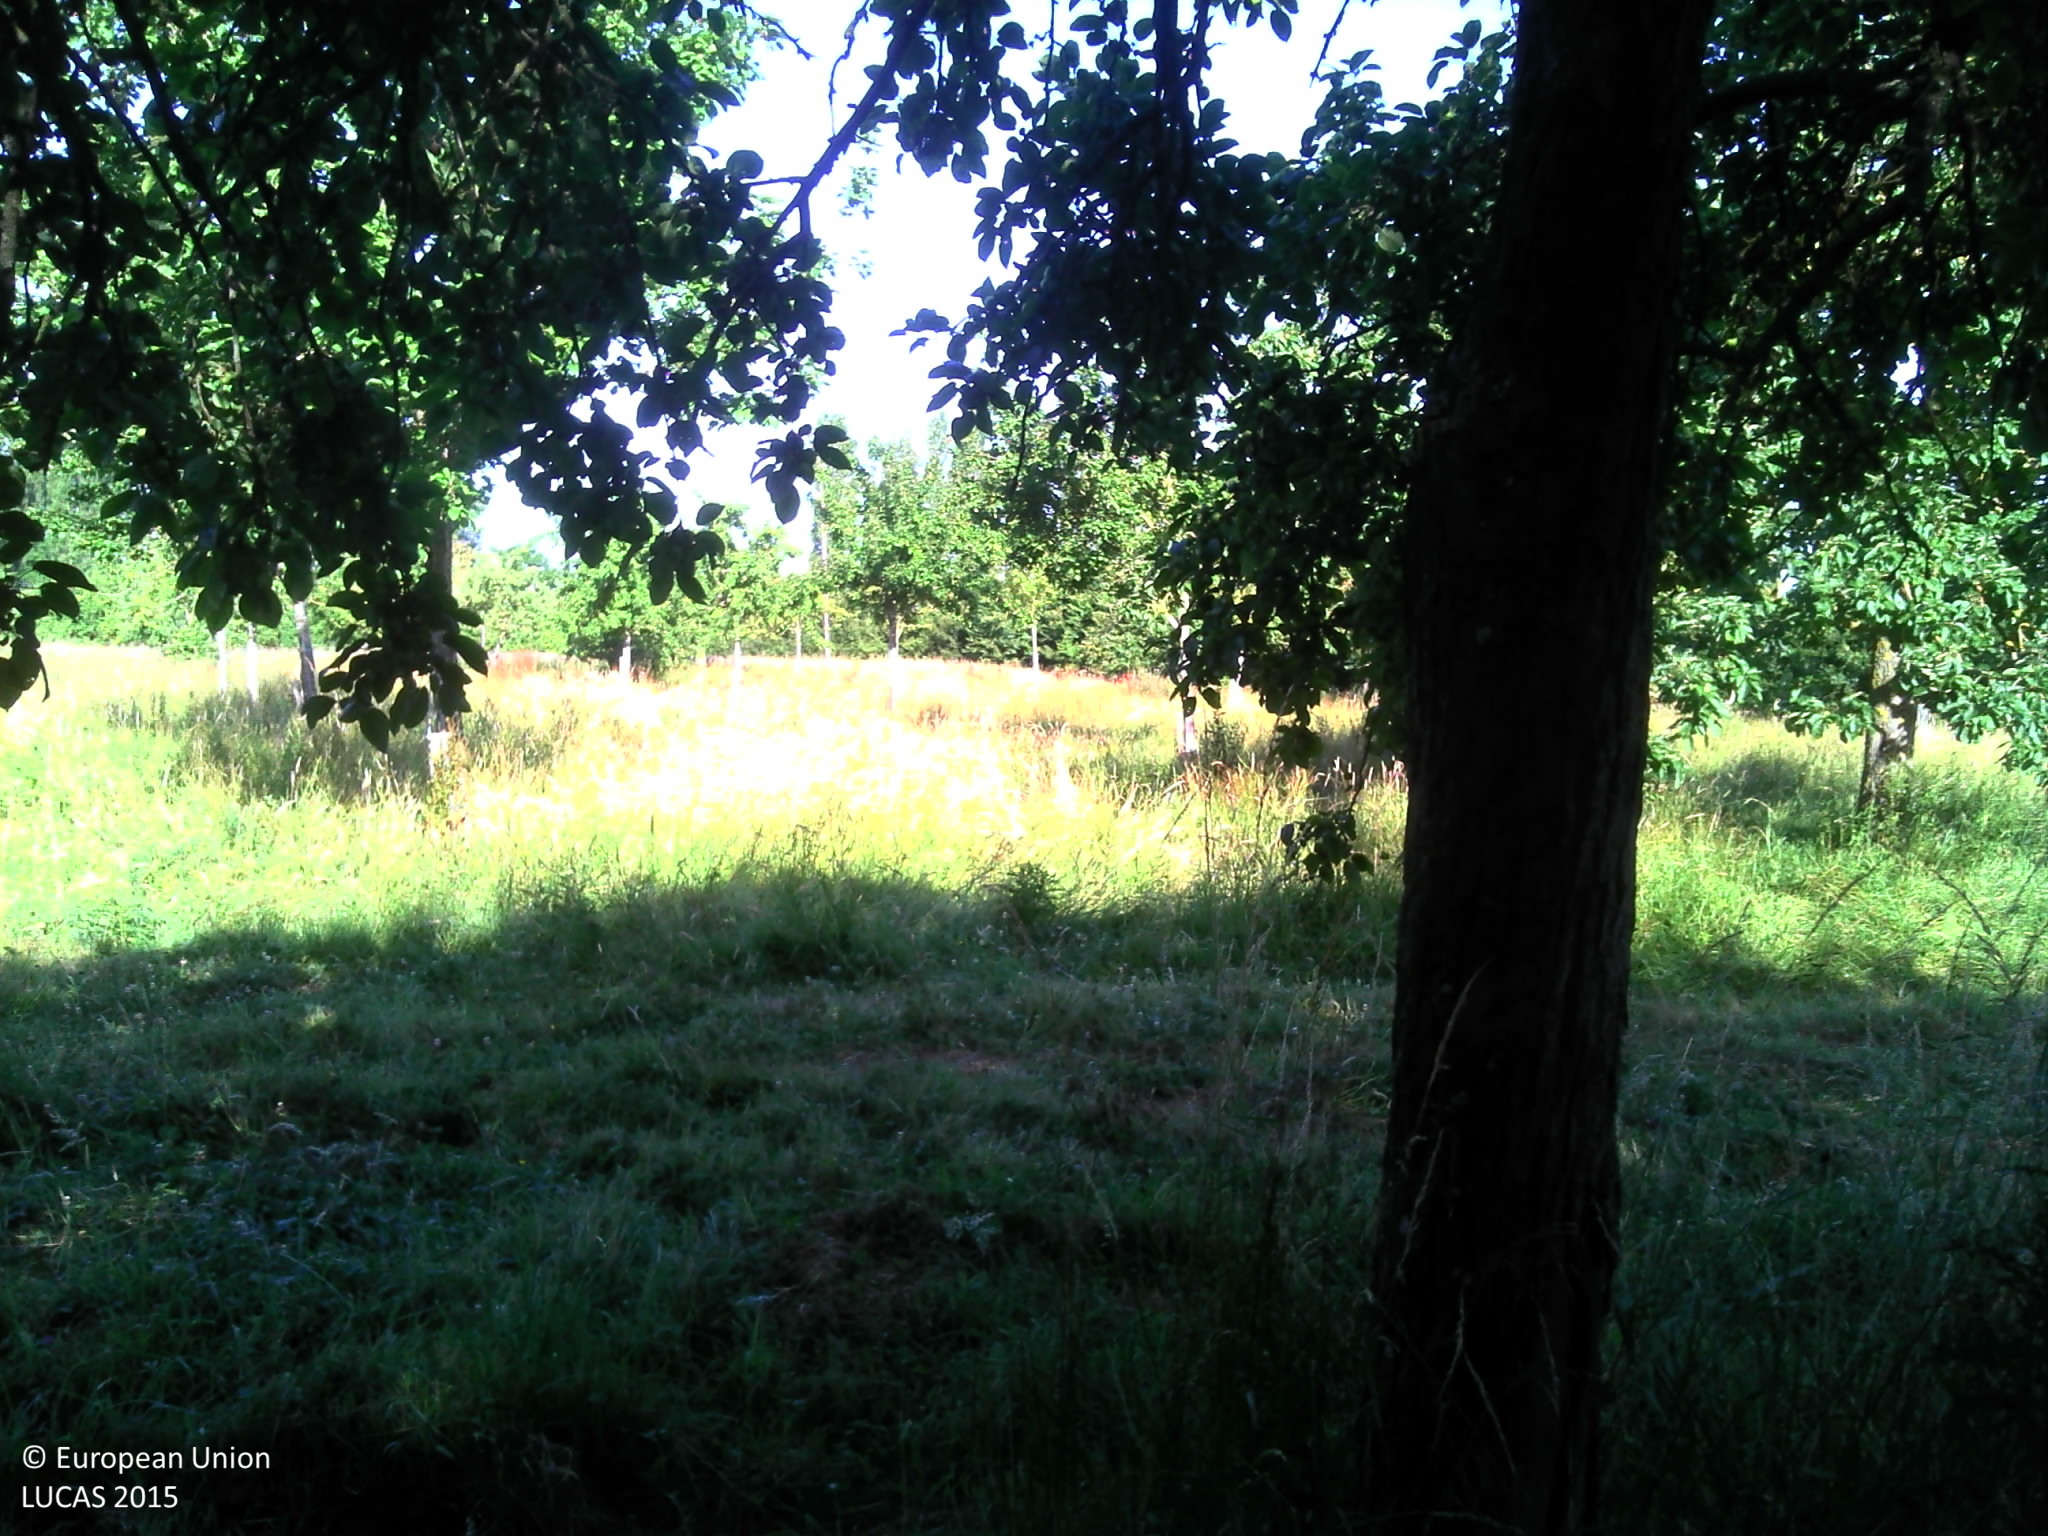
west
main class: Cropland
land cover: Apple fruit
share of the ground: 10 - 25 %
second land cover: Grassland without tree/shrub cover
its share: > 75 %
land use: Agriculture (excluding fallow land and kitchen gardens)
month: July
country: FR
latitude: 49.0365
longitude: -0.0027
